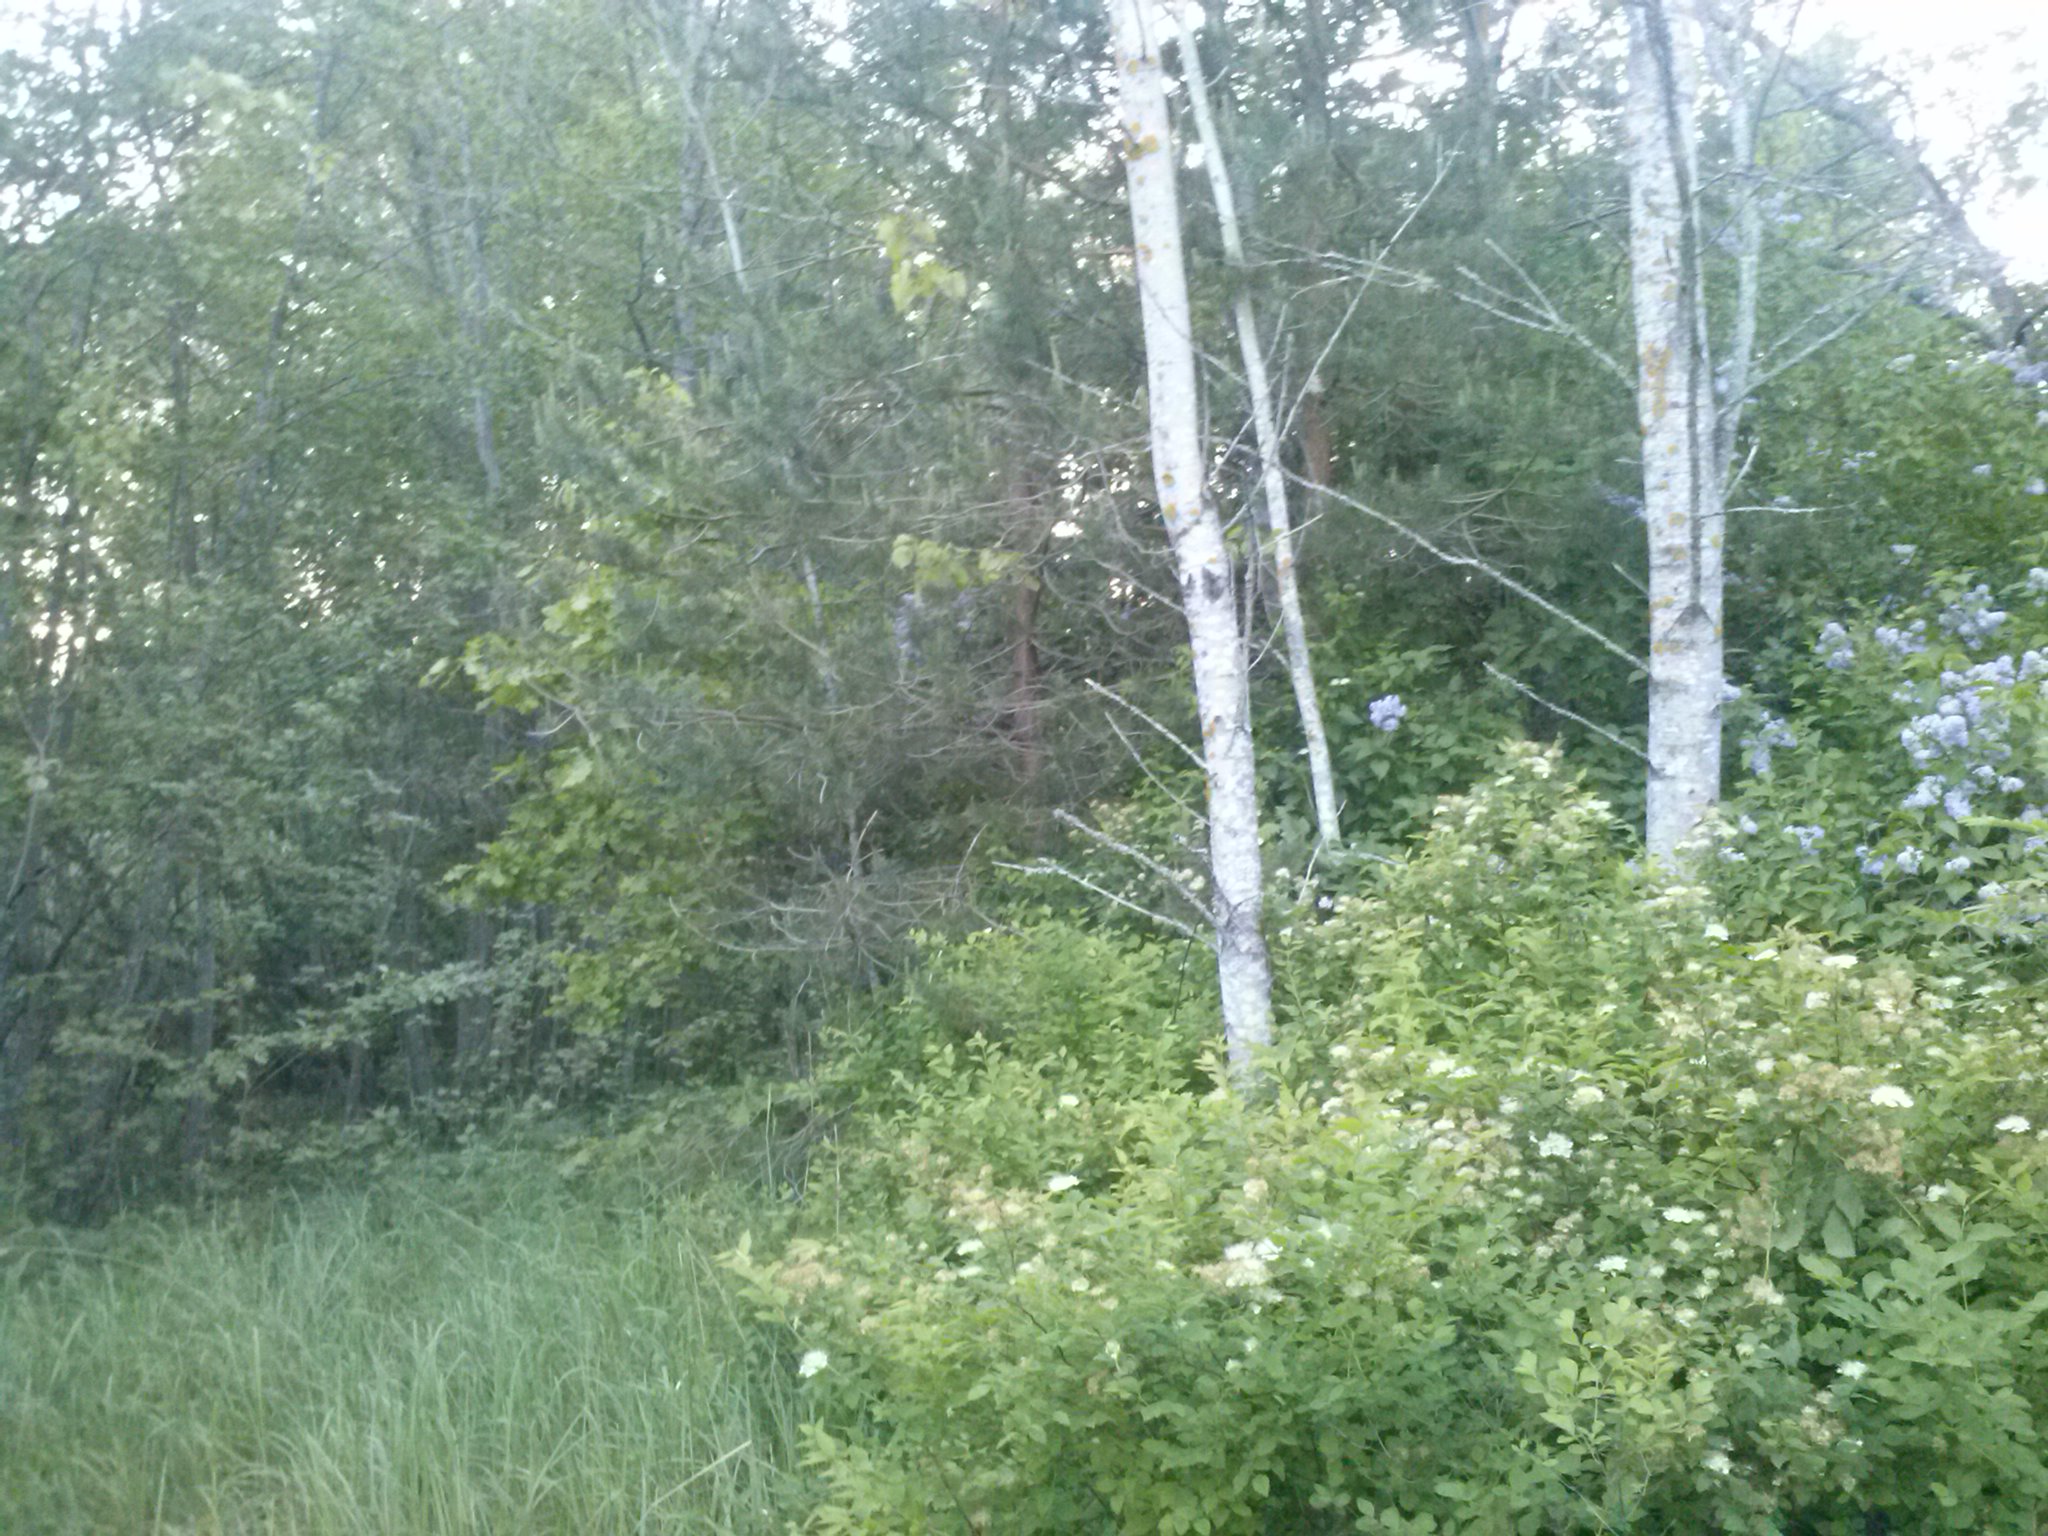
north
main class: Woodland
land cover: Pine dominated mixed woodland
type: hemiboreal forest and nemoral coniferous forest and mixed broadleaved-coniferous forest
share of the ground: > 75 %
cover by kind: coniferous forest trees 60 %, broadleaved forest trees 40 %
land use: Forestry
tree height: > 5 m
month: June
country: LV
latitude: 56.4177
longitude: 27.8443
